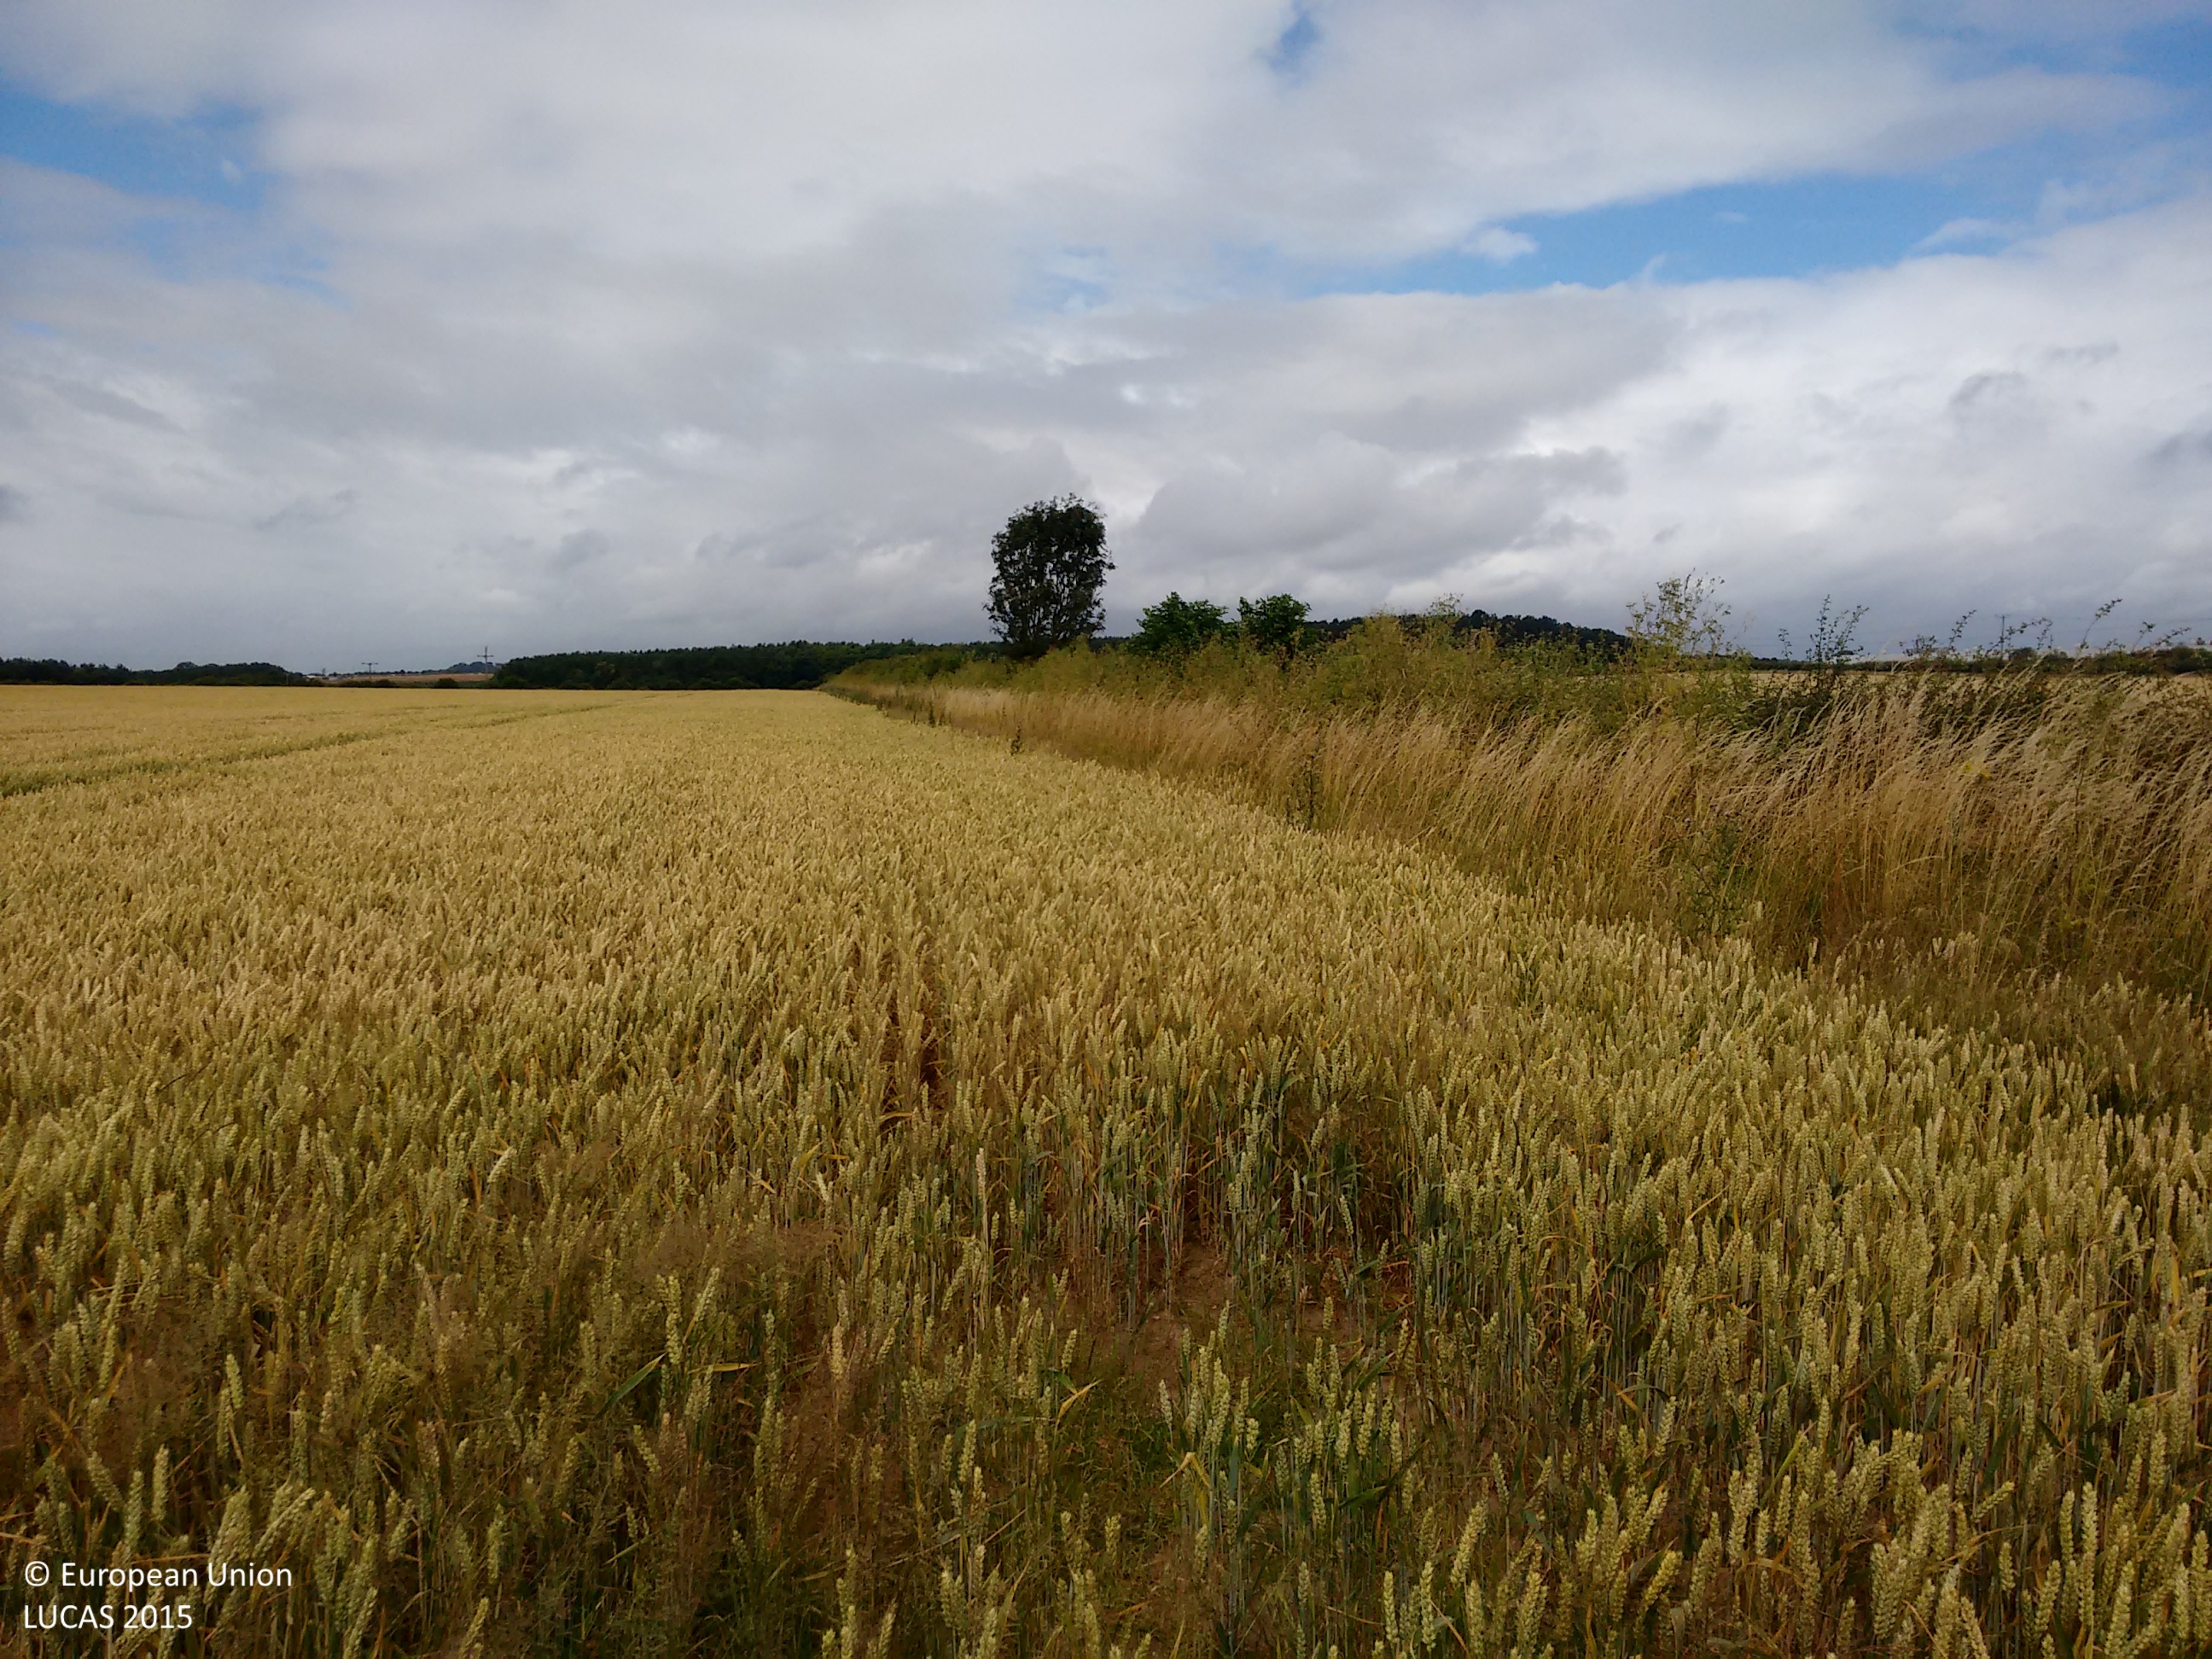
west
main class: Cropland
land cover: Common wheat
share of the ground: > 75 %
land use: Agriculture (excluding fallow land and kitchen gardens)
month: July
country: GB
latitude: 53.0915
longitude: -1.0797
